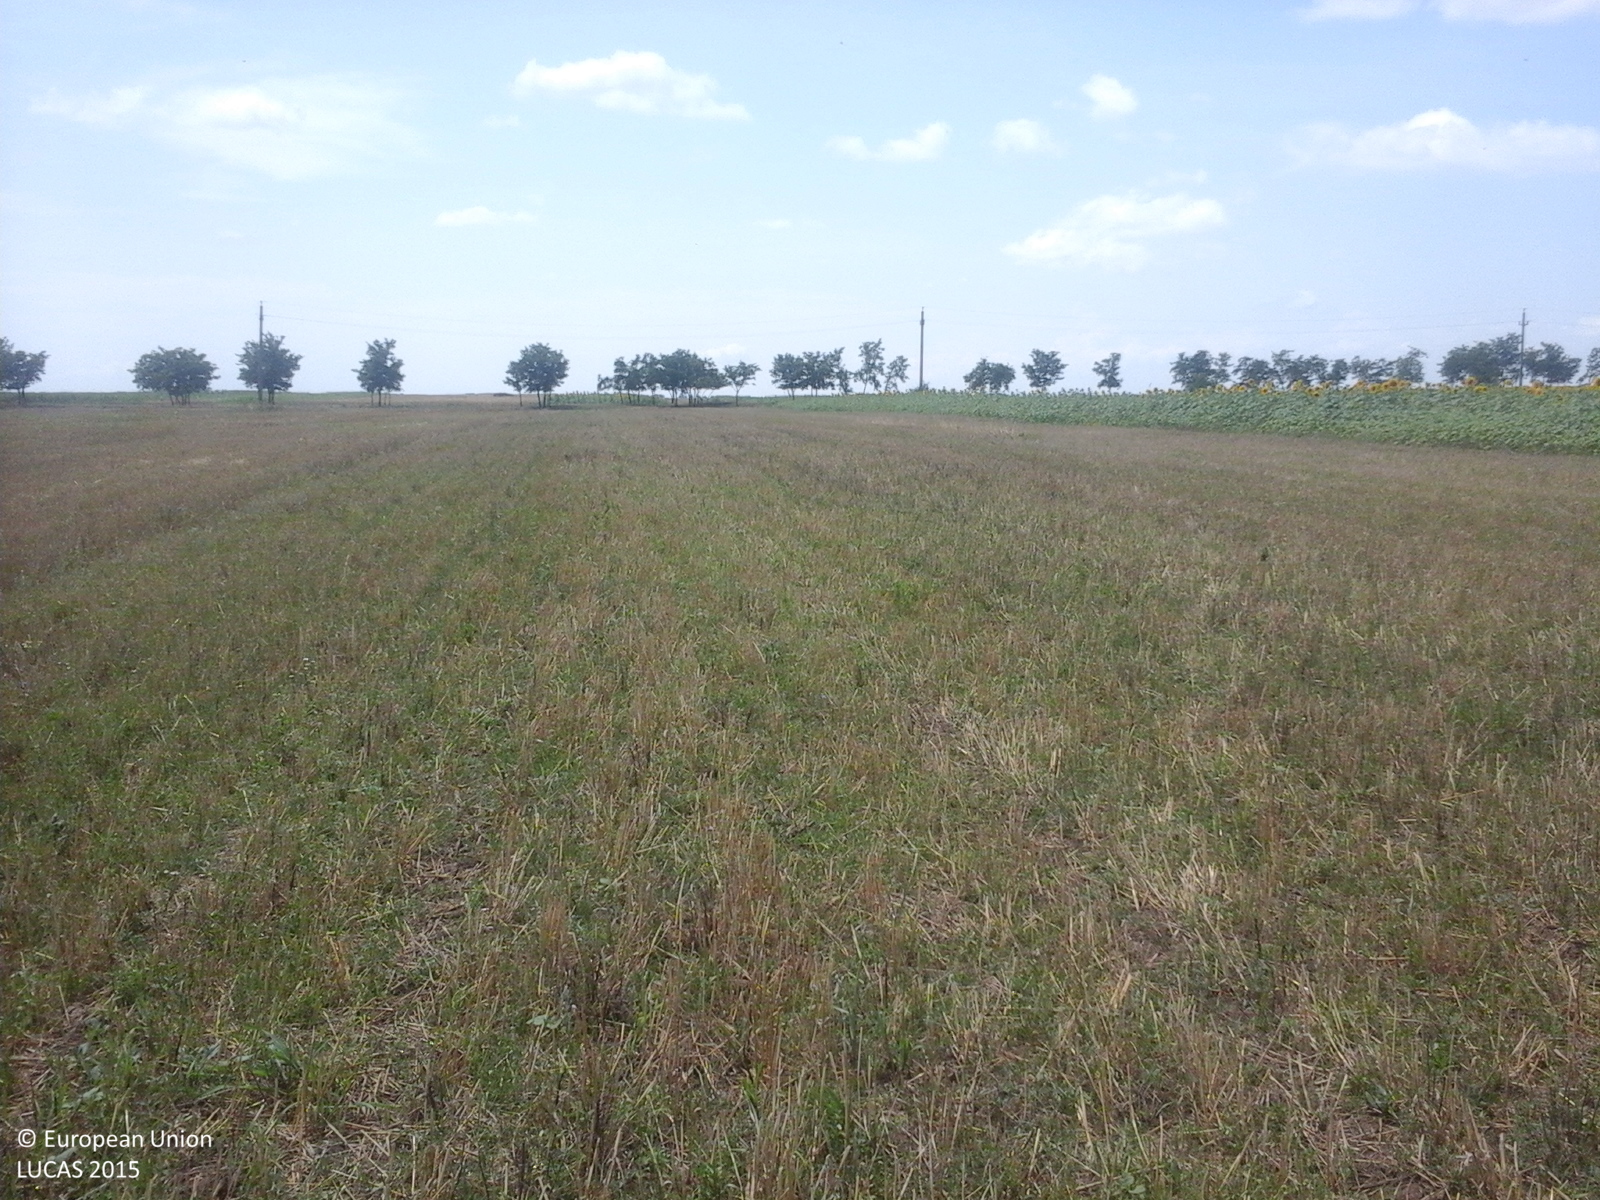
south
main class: Cropland
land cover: Common wheat
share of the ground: > 75 %
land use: Agriculture (excluding fallow land and kitchen gardens)
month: July
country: RO
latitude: 43.9319
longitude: 24.2240
